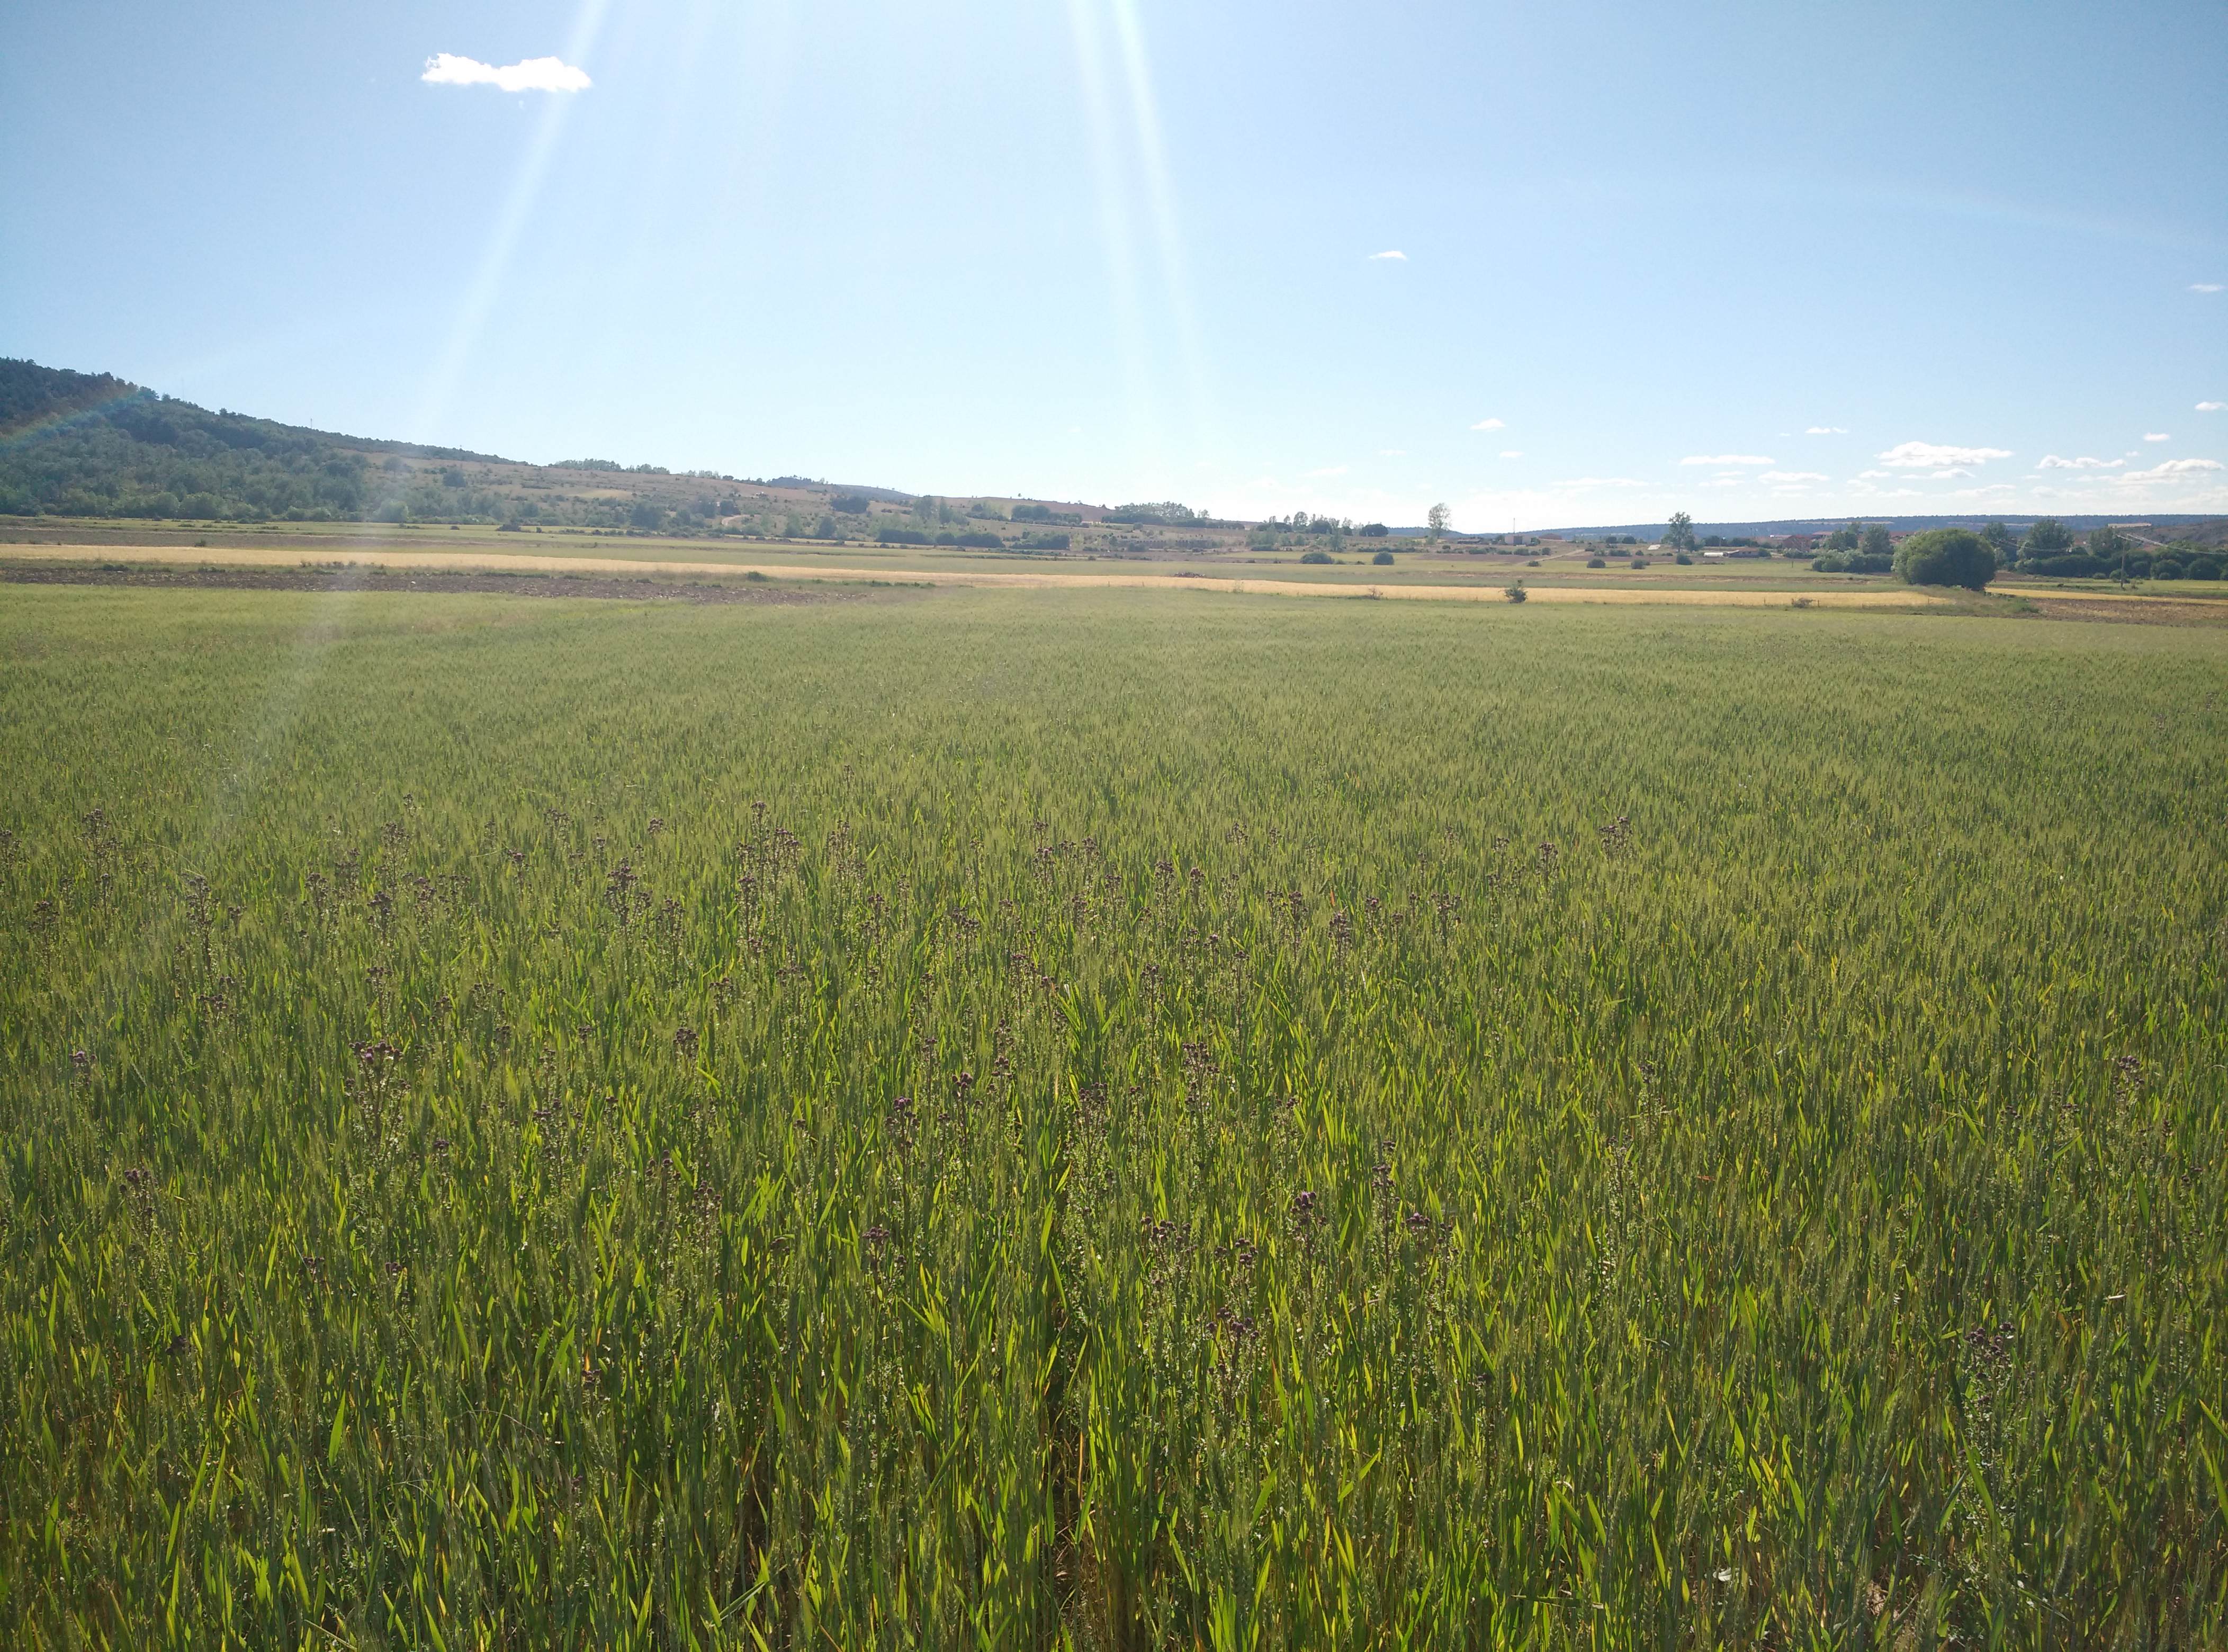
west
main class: Cropland
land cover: Common wheat
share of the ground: > 75 %
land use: Agriculture (excluding fallow land and kitchen gardens)
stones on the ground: 10 - 25 %
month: June
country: ES
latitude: 40.6198
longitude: -1.7328
